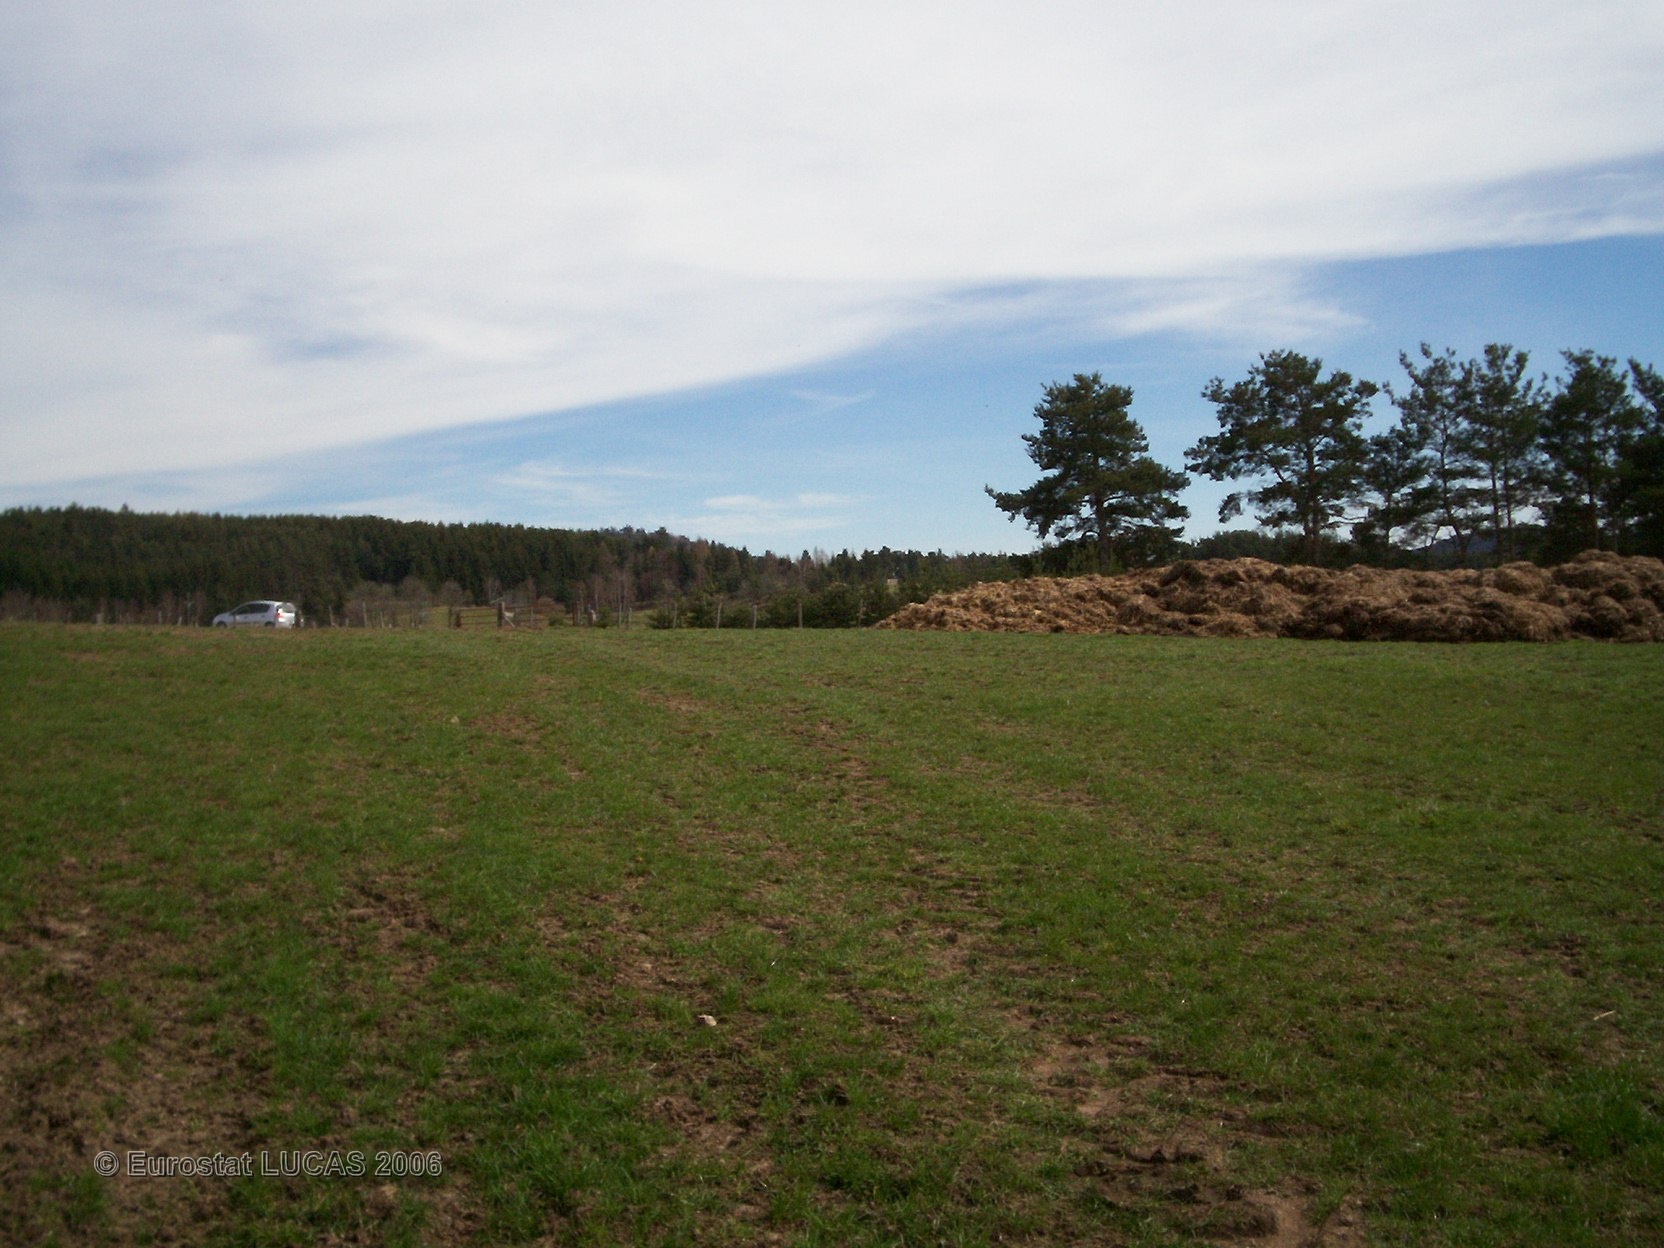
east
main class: Grassland
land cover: Grassland without tree/shrub cover
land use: Agriculture (excluding fallow land and kitchen gardens)
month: April
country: FR
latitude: 44.8206
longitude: 3.2883
